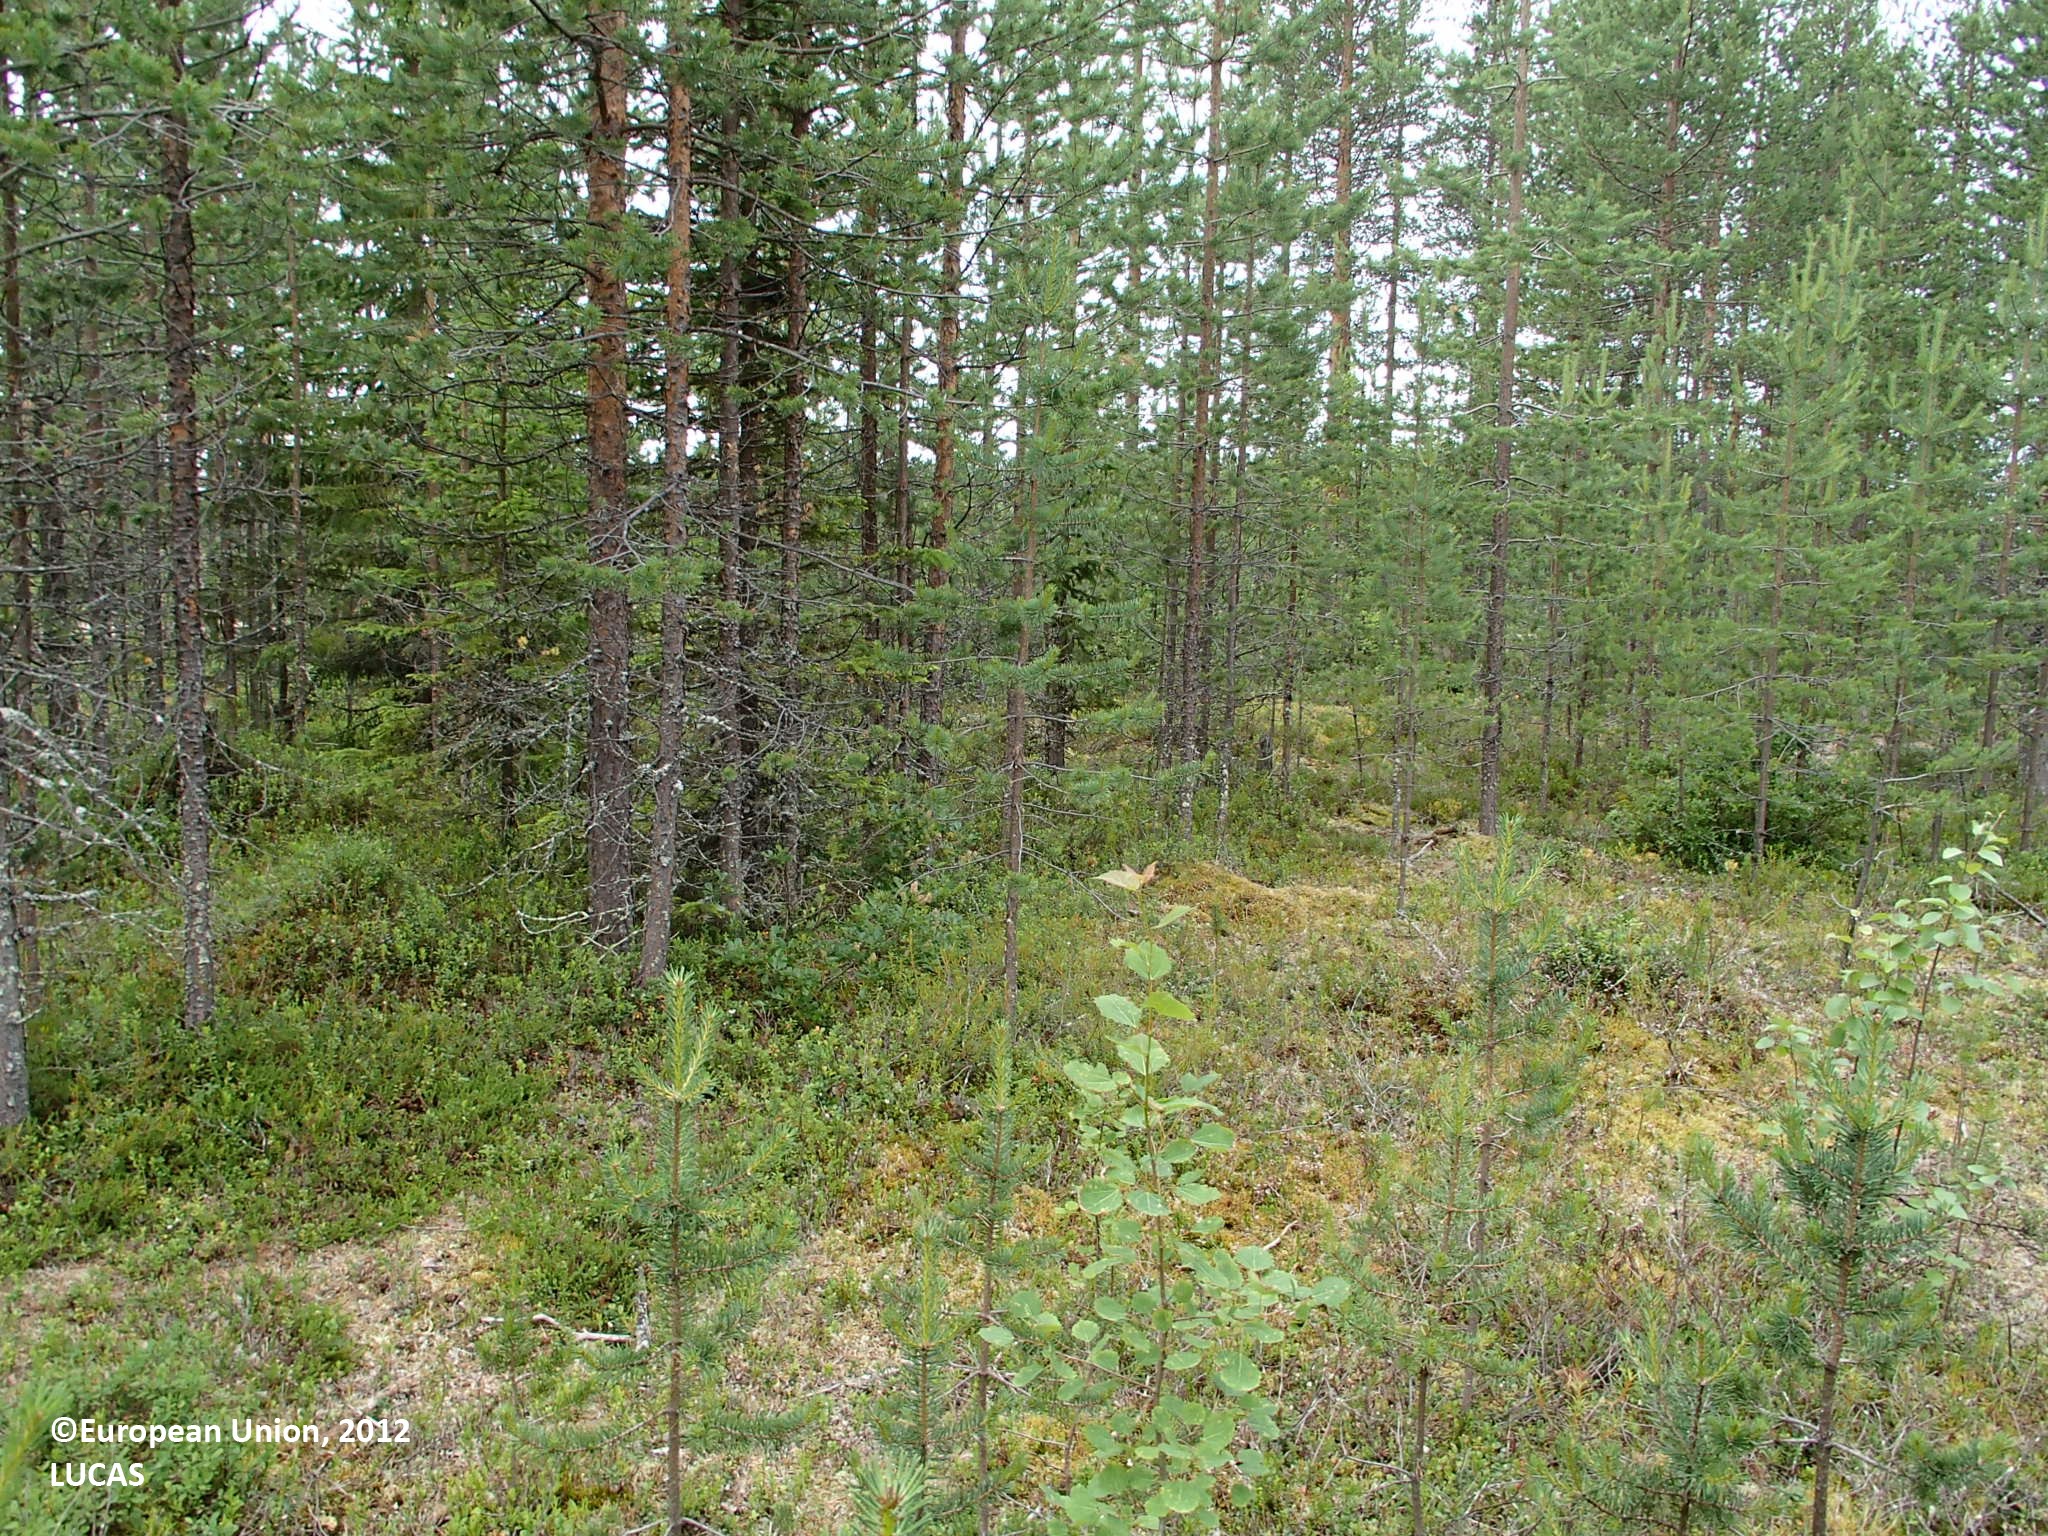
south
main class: Woodland
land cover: Other mixed woodland
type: boreal forest
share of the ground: 50 - 75 %
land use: Forestry
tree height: > 5 m
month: July
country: FI
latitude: 66.9170
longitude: 25.3925
